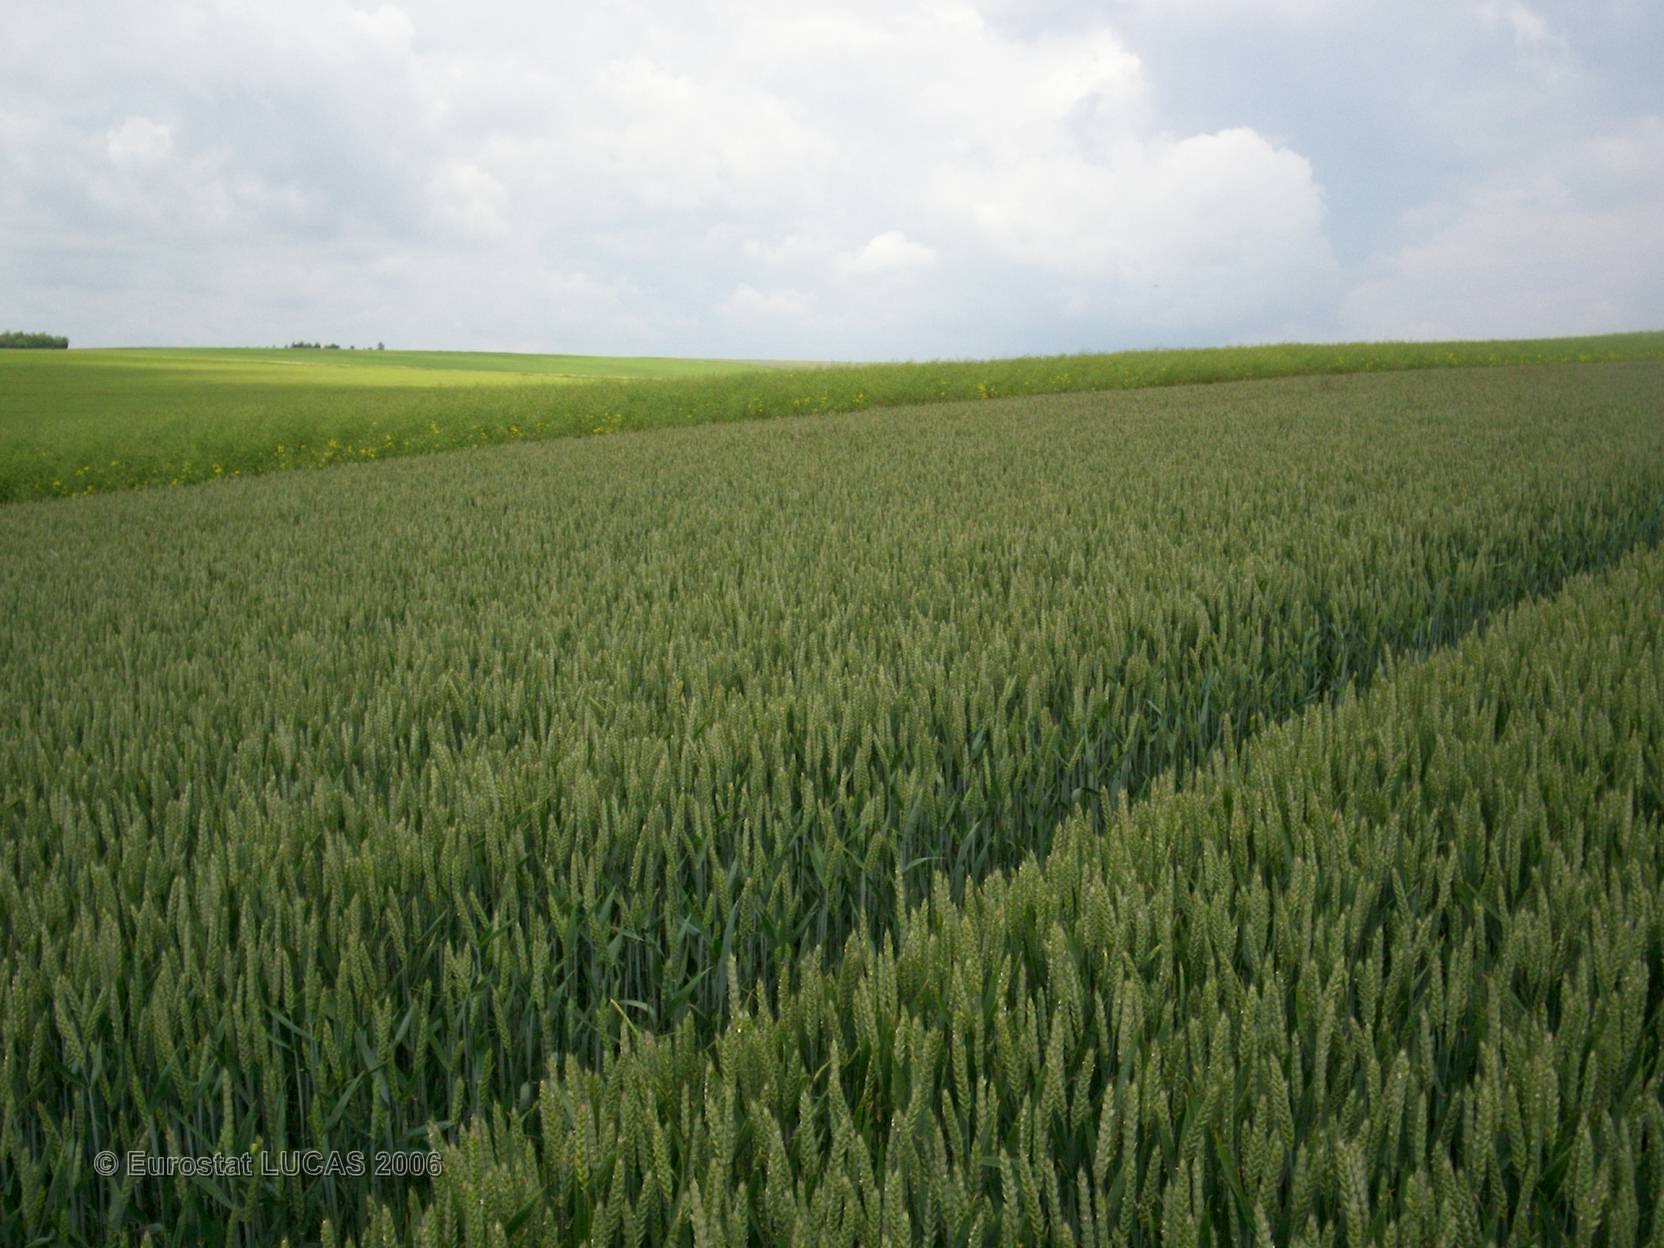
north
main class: Cropland
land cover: Common wheat
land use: Agriculture (excluding fallow land and kitchen gardens)
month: June
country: FR
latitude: 48.6081
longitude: 4.4771
